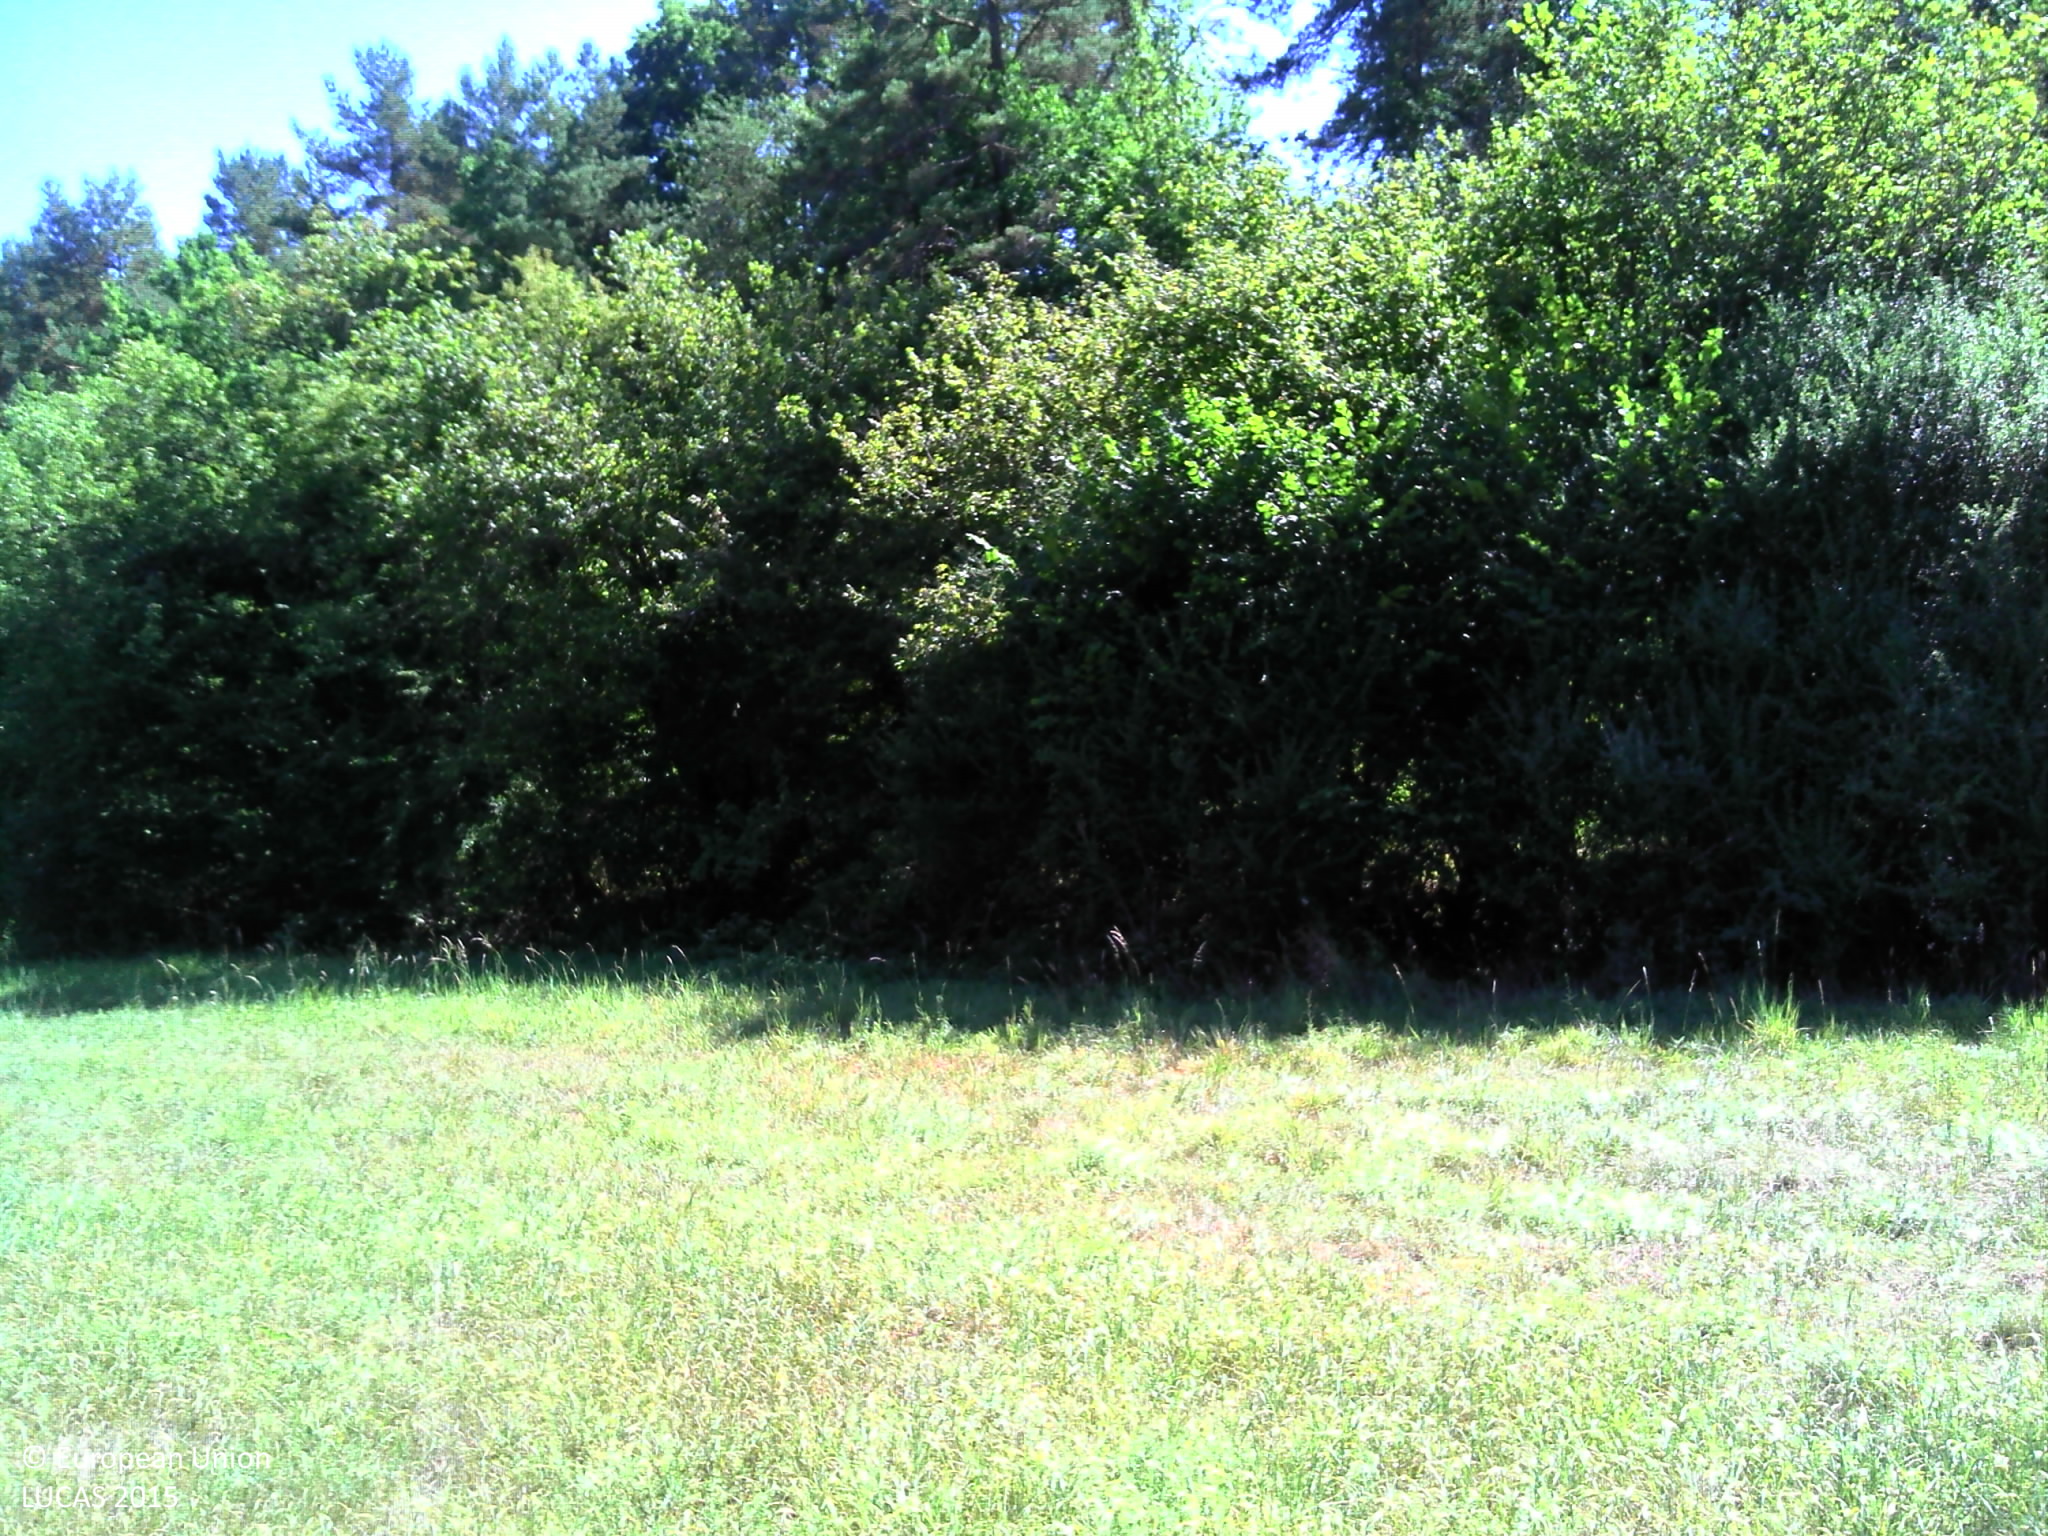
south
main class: Grassland
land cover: Grassland without tree/shrub cover
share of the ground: > 75 %
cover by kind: herbaceous plants 100 %
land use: Agriculture (excluding fallow land and kitchen gardens)
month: August
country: FR
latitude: 47.8069
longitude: 5.0724
